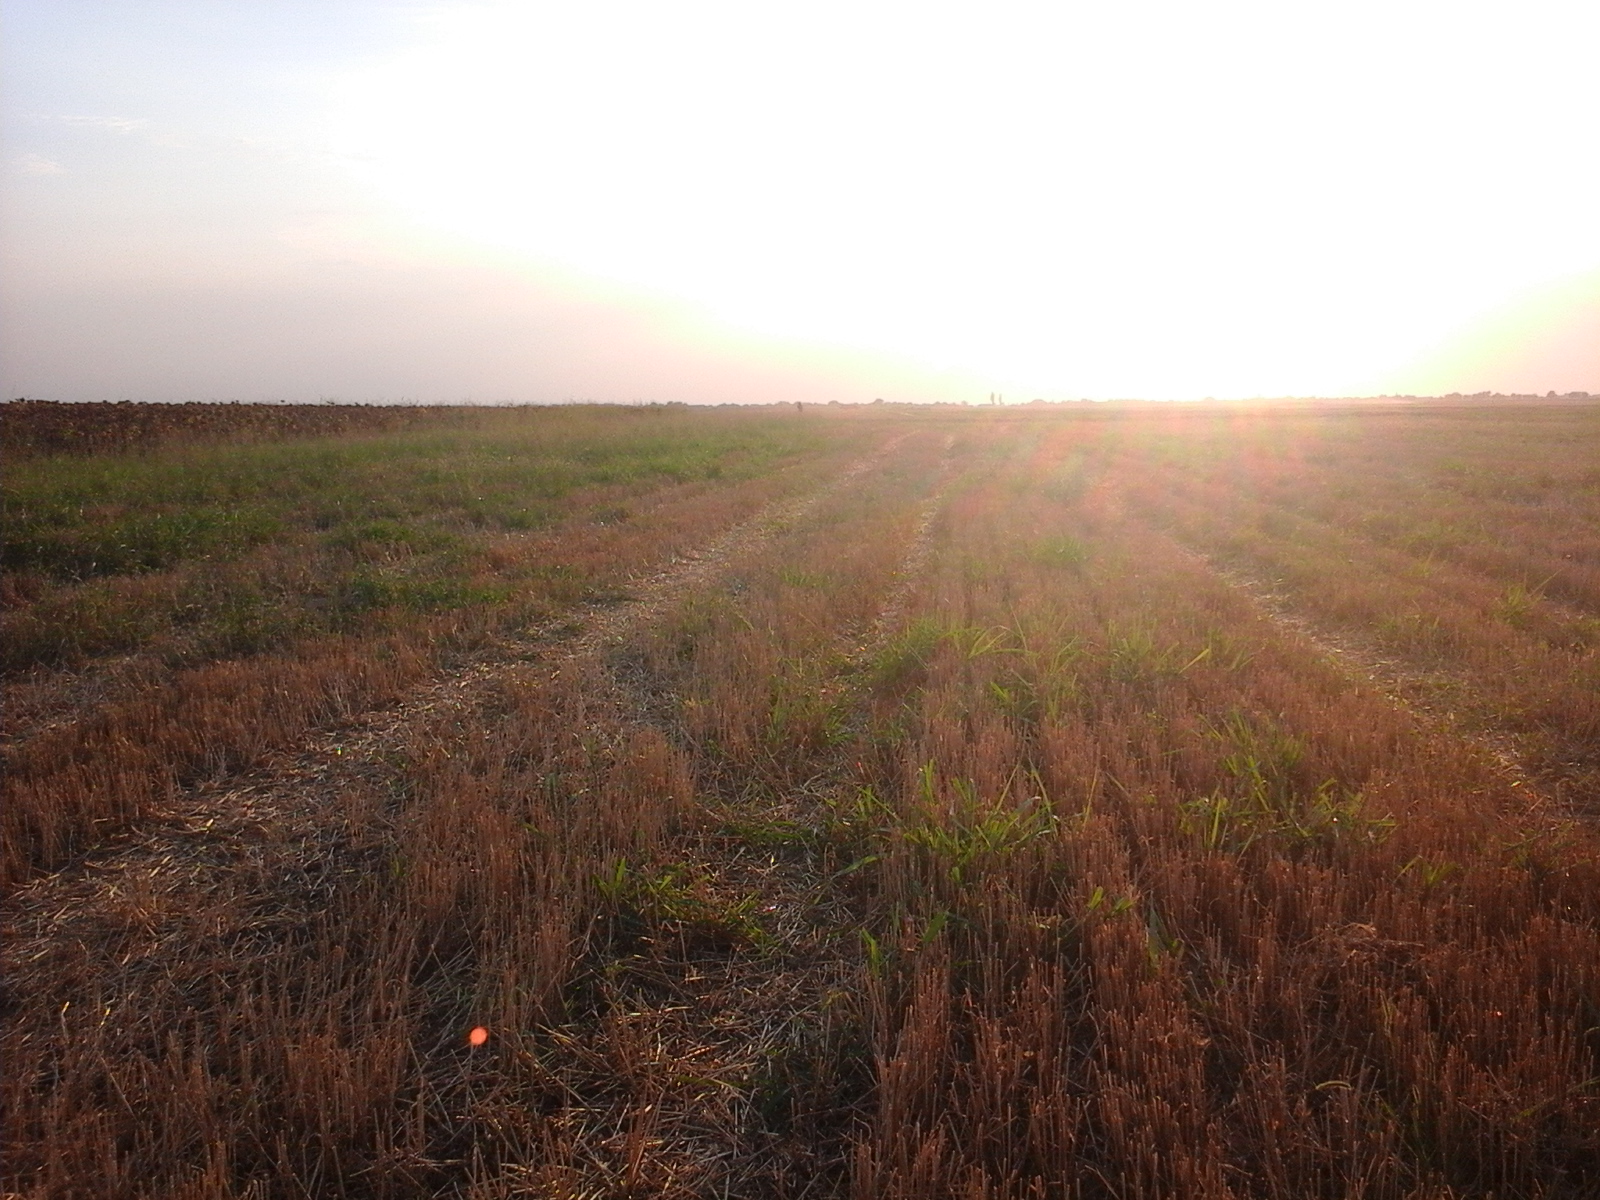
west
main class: Cropland
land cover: Common wheat
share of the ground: 50 - 75 %
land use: Agriculture (excluding fallow land and kitchen gardens)
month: August
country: RO
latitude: 44.0010
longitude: 23.5815
